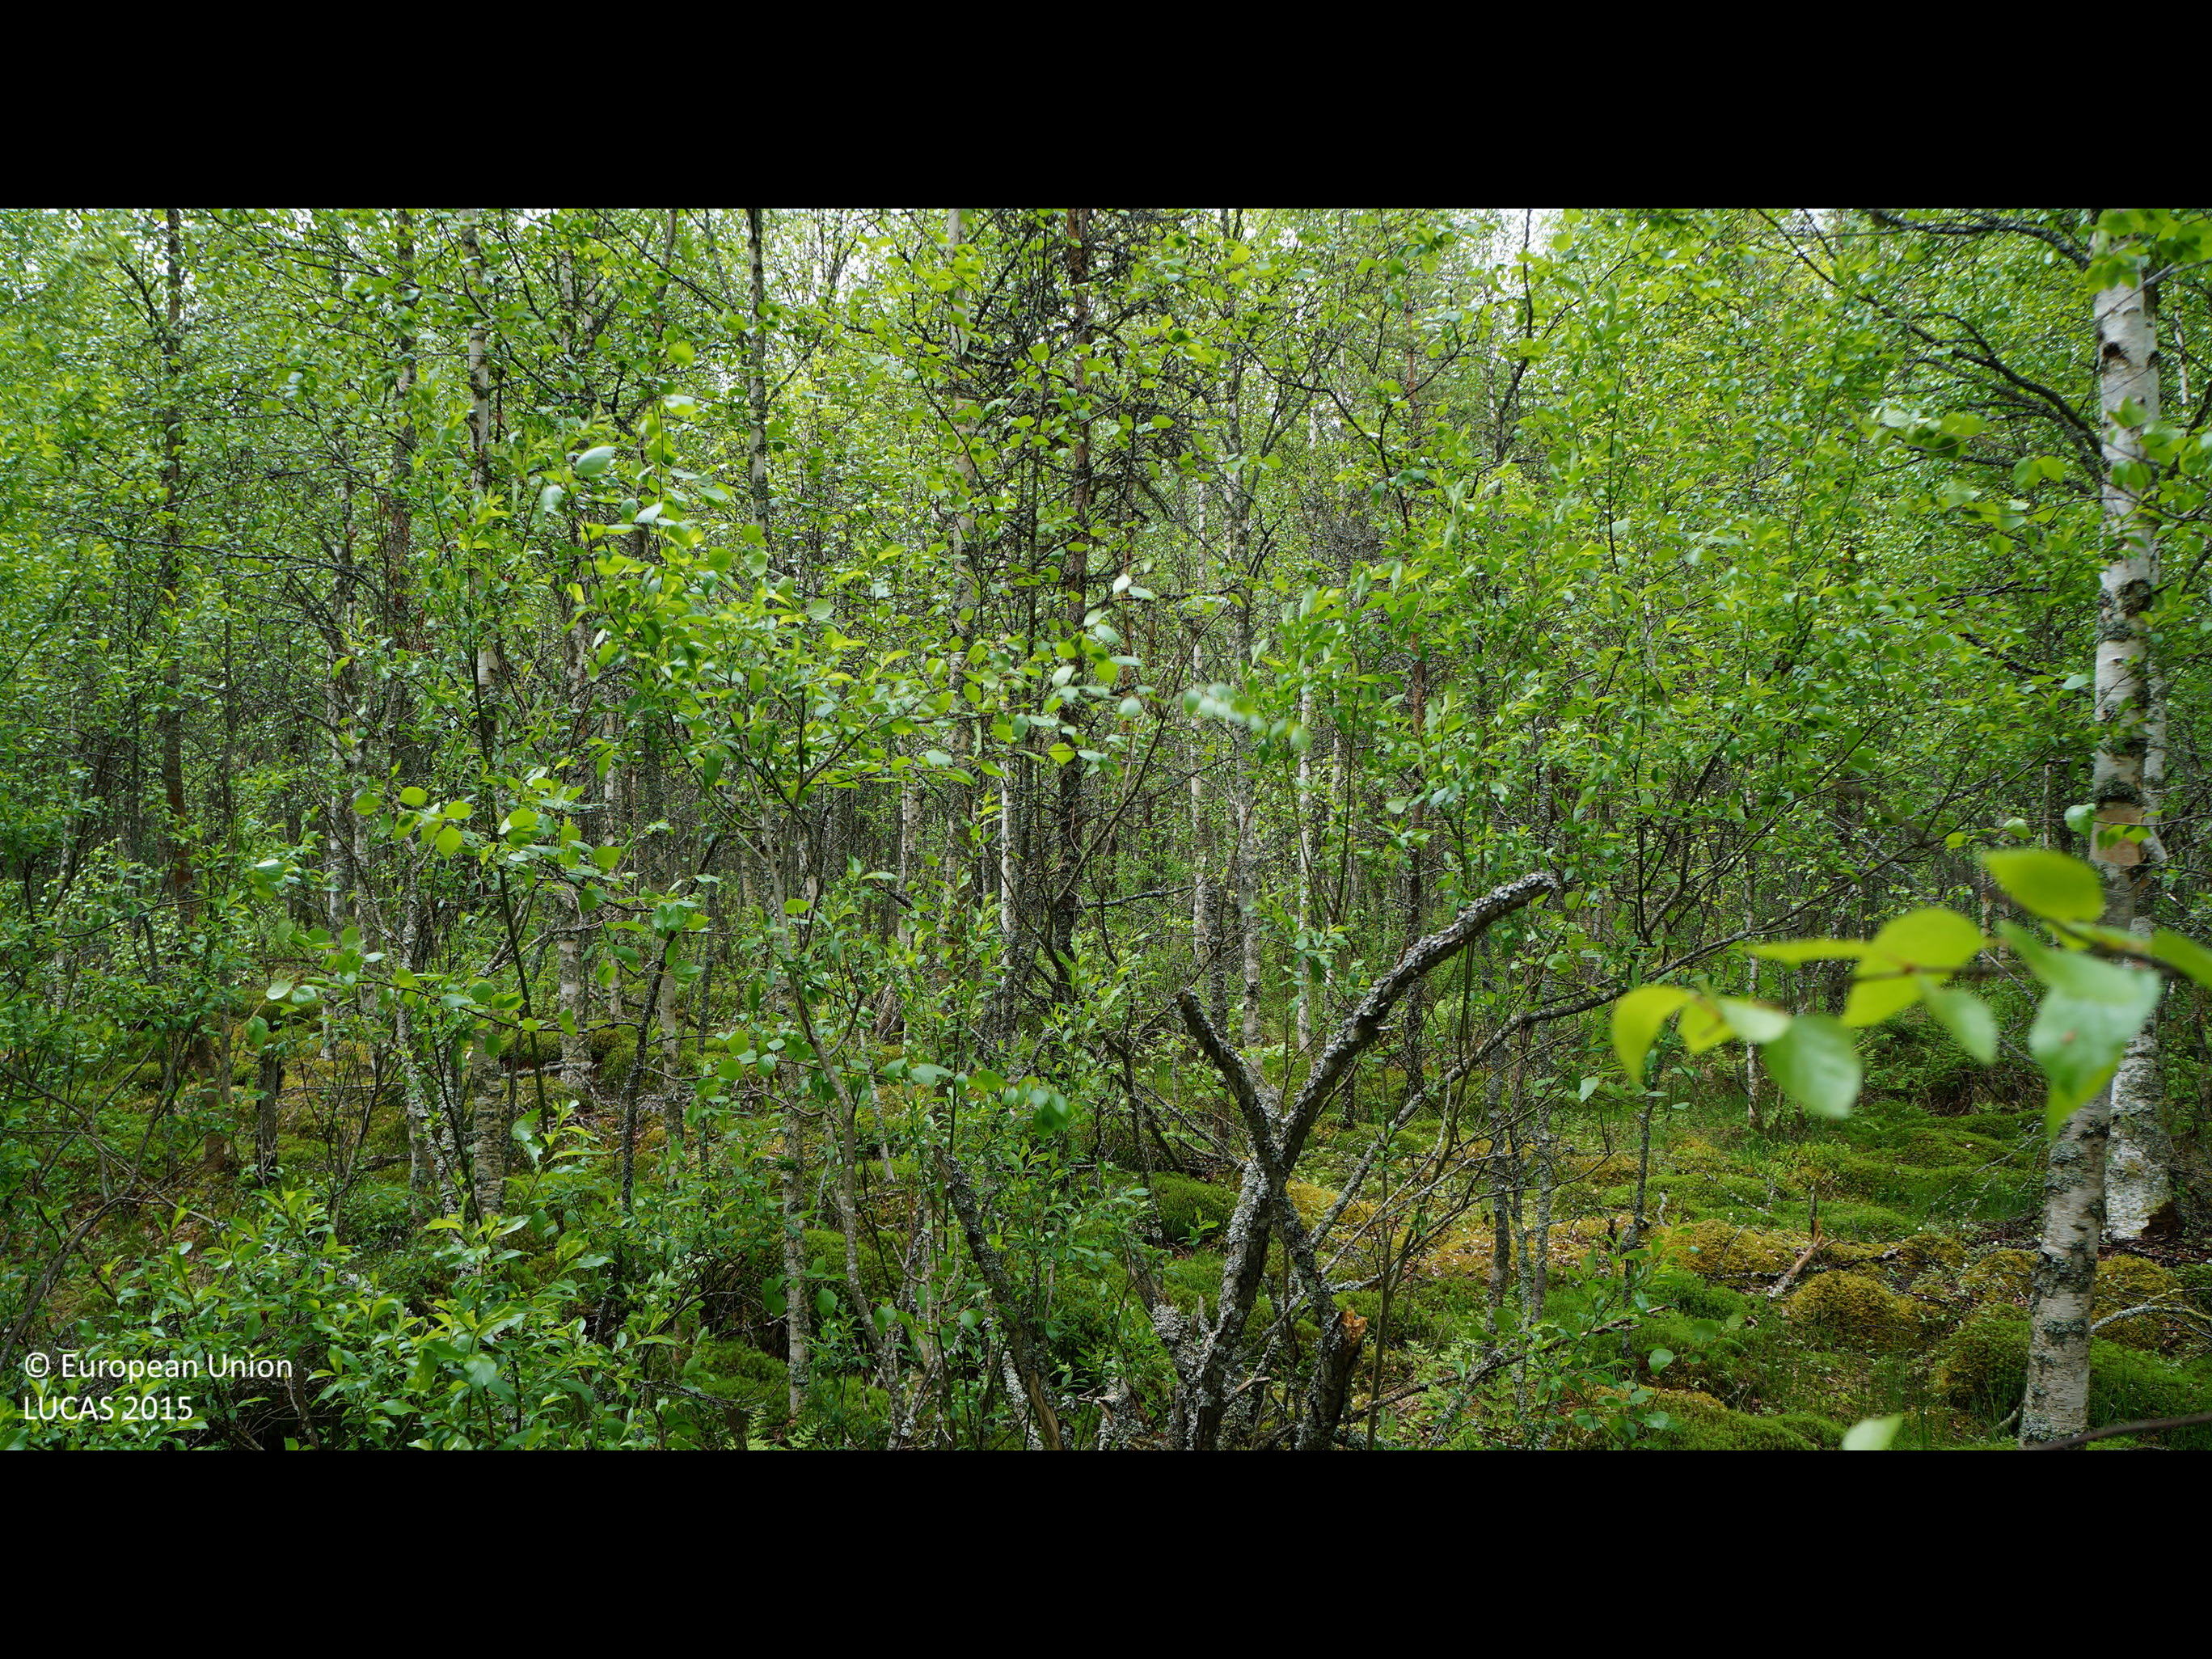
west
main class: Woodland
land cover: Broadleaved woodland
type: non-riverine alder, birch or aspen forest
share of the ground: > 75 %
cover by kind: broadleaved forest trees 90 %, shrubs 5 %, herbaceous plants 5 %
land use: Forestry
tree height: > 5 m
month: June
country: FI
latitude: 63.9888
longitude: 25.2343
